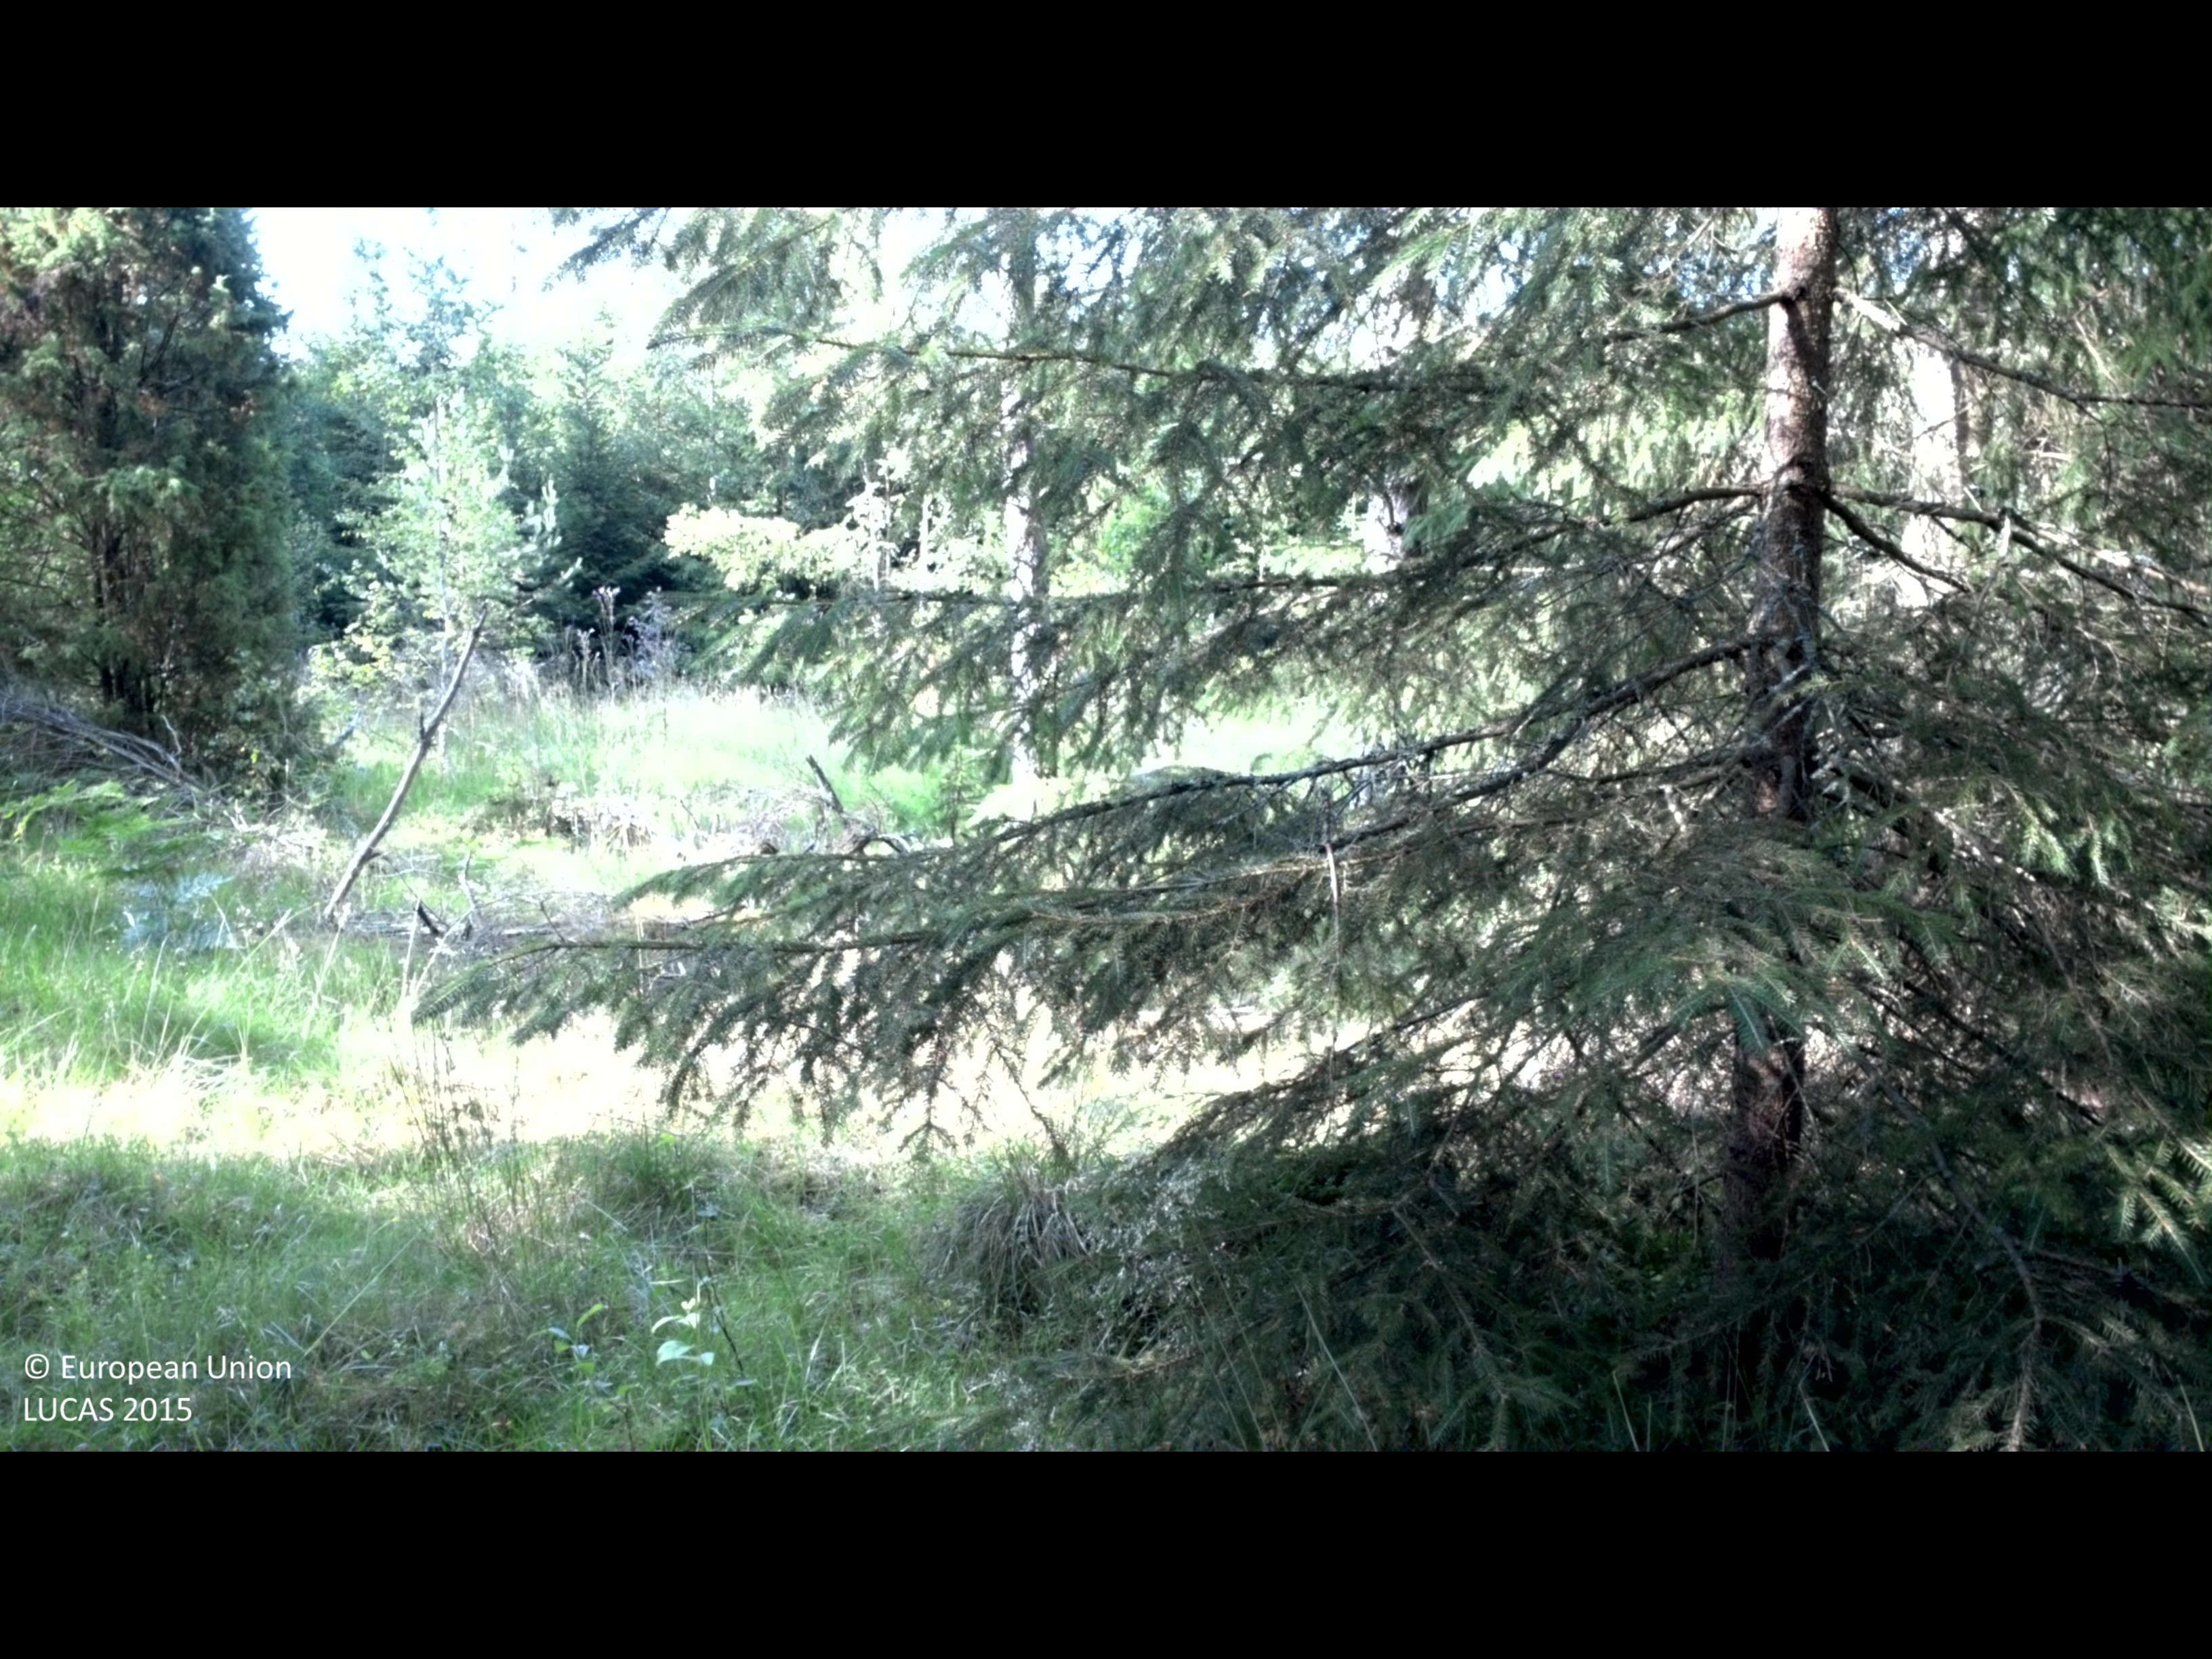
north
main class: Woodland
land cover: Pine dominated coniferous woodland
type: boreal forest
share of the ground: 50 - 75 %
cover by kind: coniferous forest trees 65 %, shrubs 20 %, herbaceous plants 10 %, broadleaved forest trees 5 %
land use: Forestry
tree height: > 5 m
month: July
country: SE
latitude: 58.3962
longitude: 16.6865
